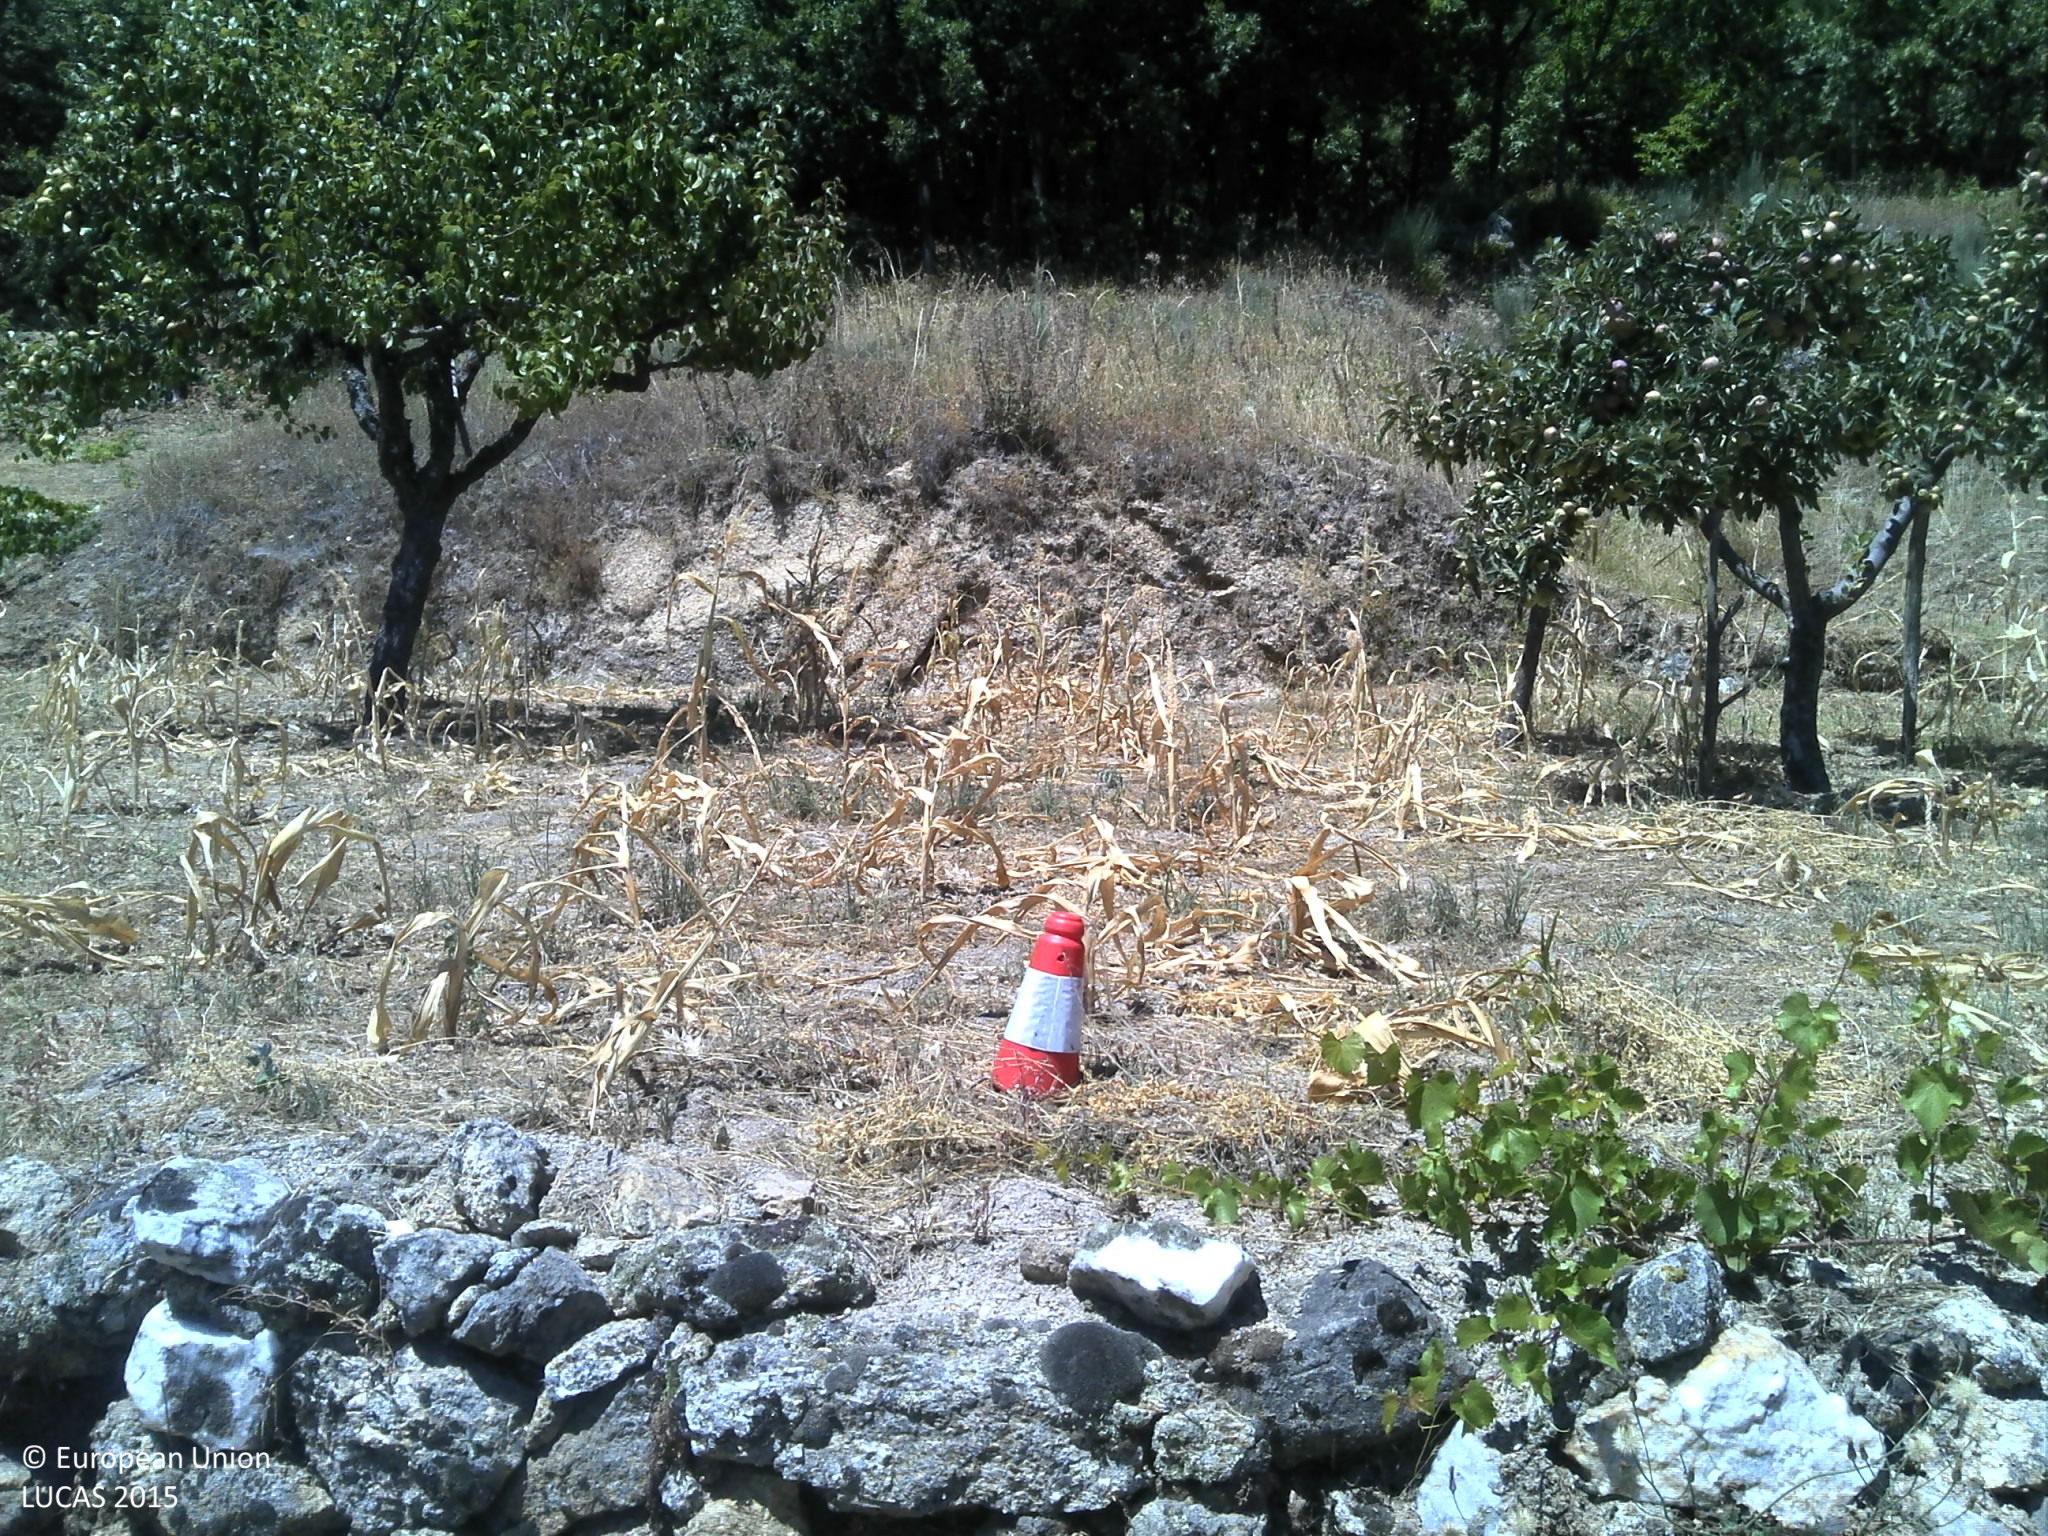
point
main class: Cropland
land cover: Pear fruit
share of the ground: 10 - 25 %
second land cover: Maize
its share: < 10 %
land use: Agriculture (excluding fallow land and kitchen gardens)
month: July
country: PT
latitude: 40.4200
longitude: -7.3726
